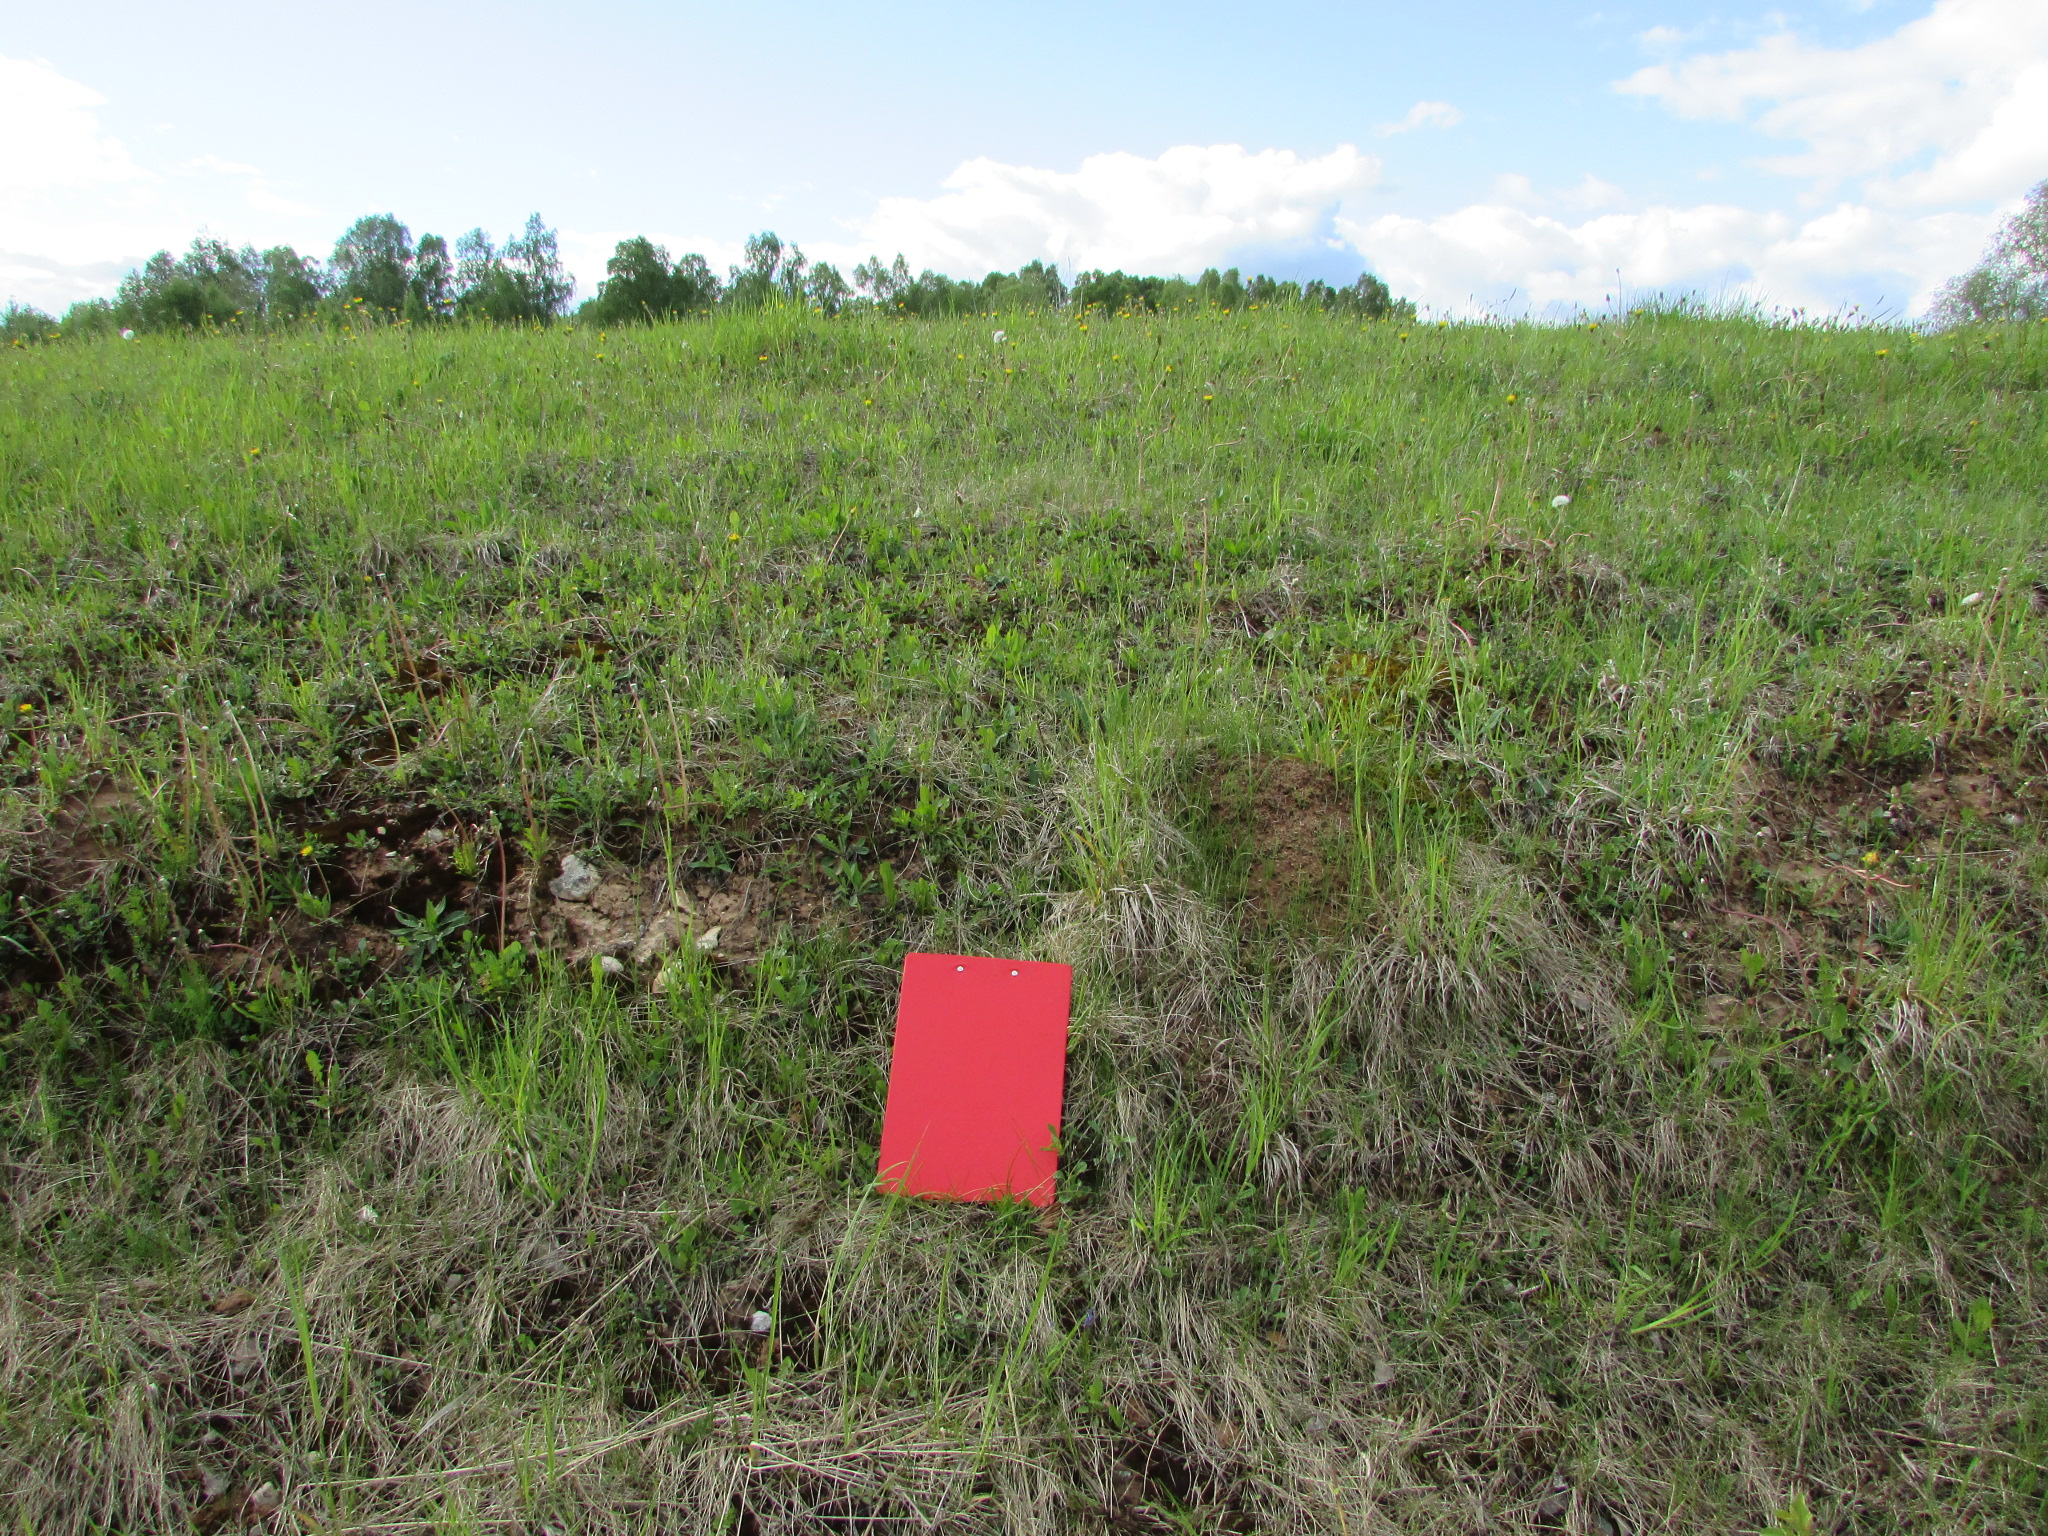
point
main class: Grassland
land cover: Grassland without tree/shrub cover
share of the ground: > 75 %
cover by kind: herbaceous plants 100 %
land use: Agriculture (excluding fallow land and kitchen gardens)
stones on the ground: < 10 %
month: May
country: LV
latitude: 56.1356
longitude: 27.0791
